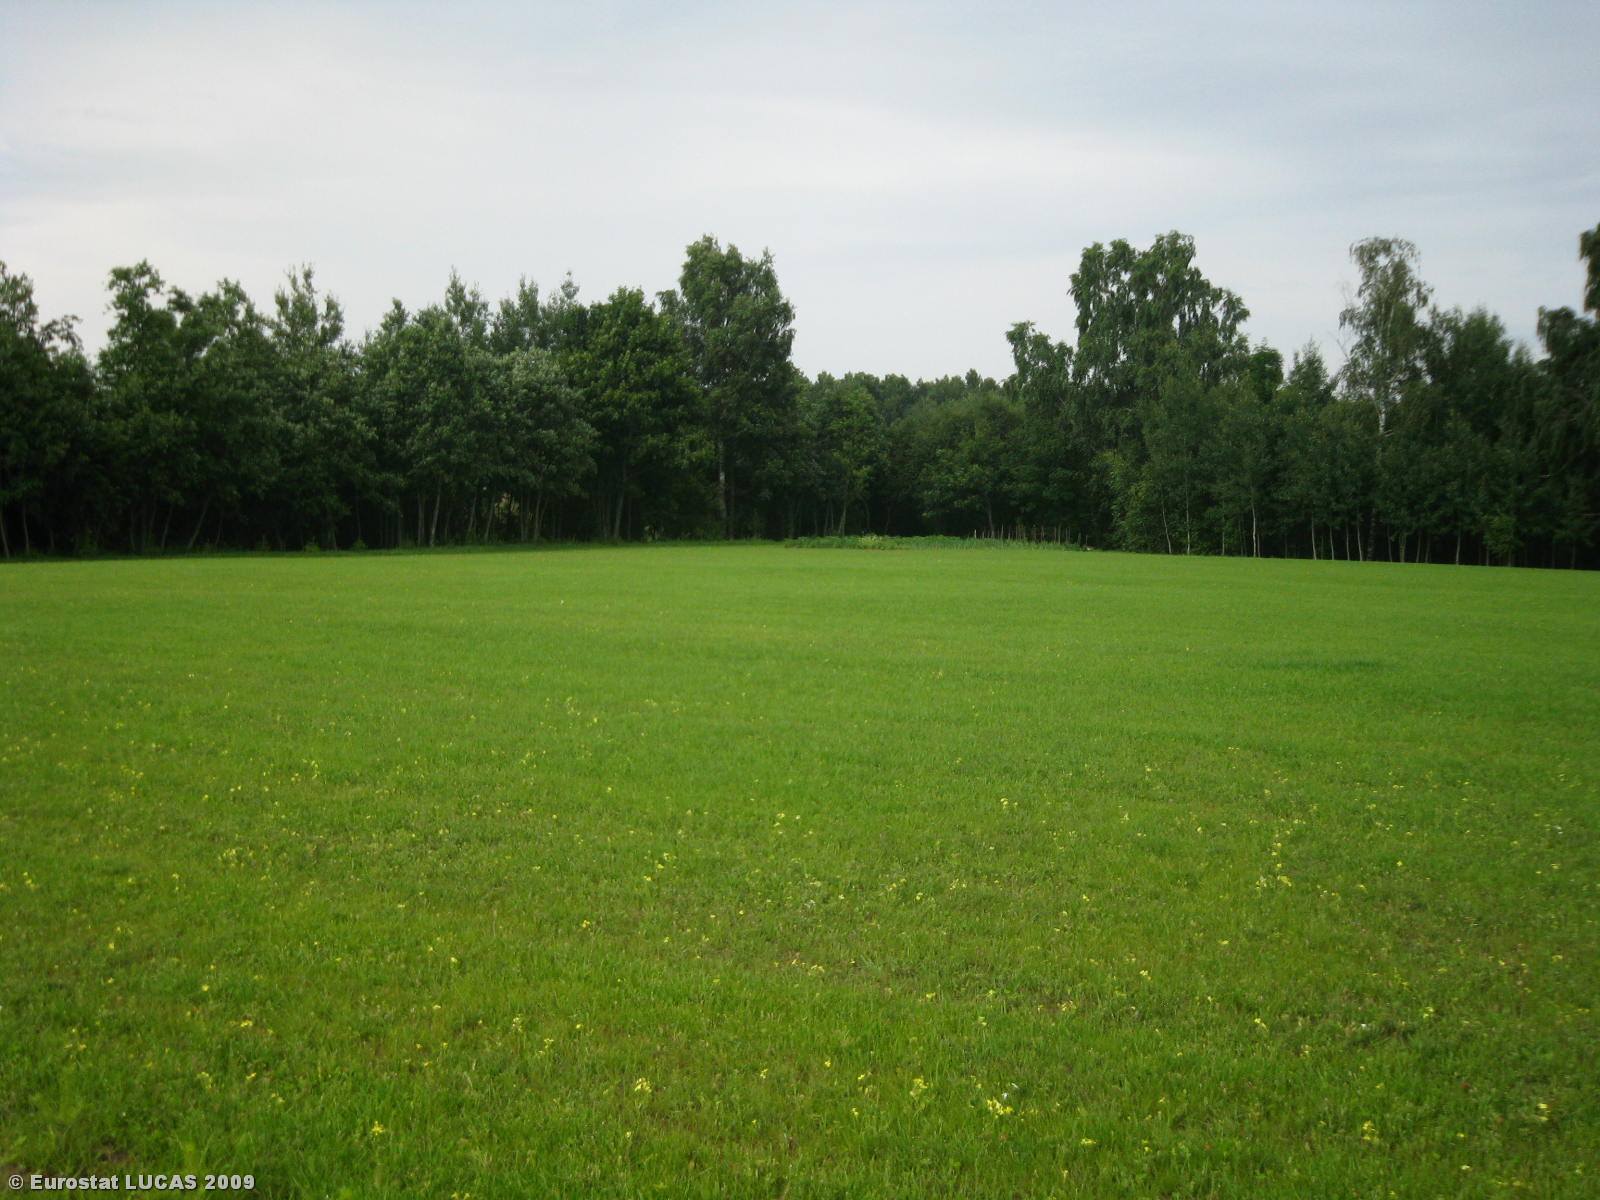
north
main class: Grassland
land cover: Grassland with sparse tree/shrub cover
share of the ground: > 75 %
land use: Forestry
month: July
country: LT
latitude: 55.2752
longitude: 24.8908
